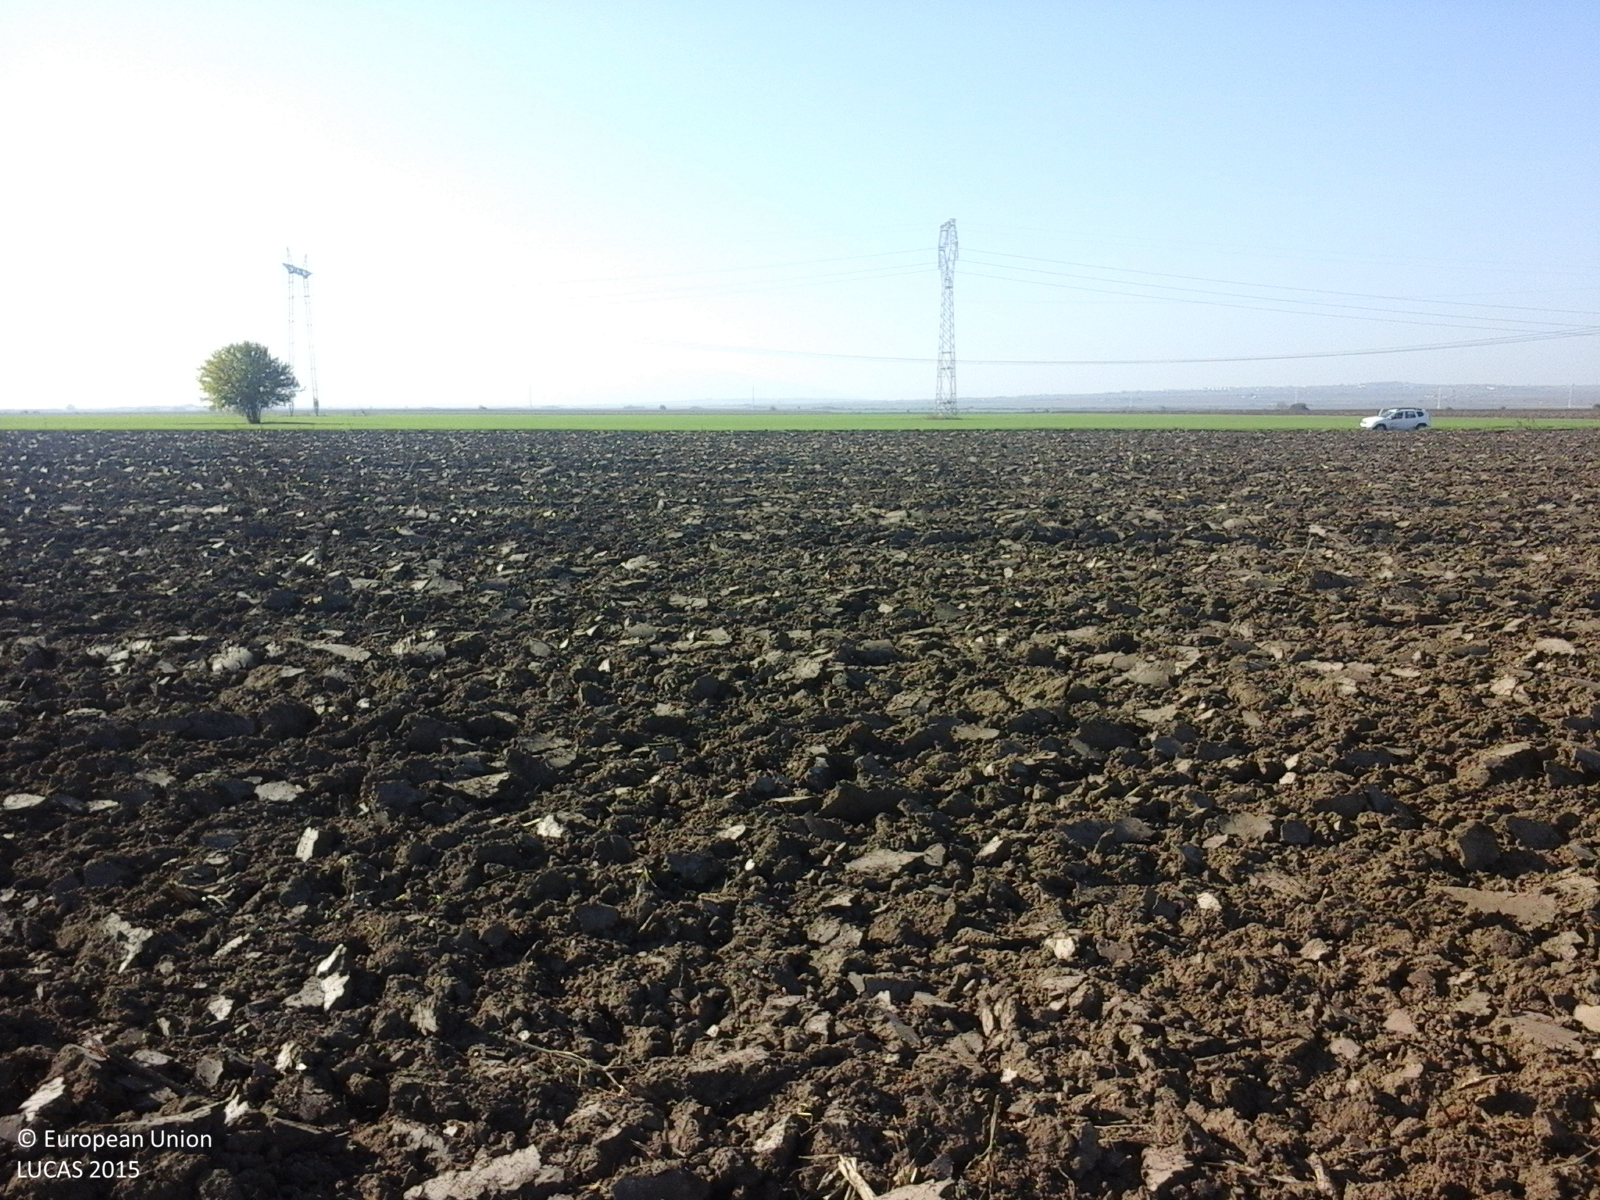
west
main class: Cropland
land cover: Maize
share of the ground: < 10 %
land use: Agriculture (excluding fallow land and kitchen gardens)
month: October
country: RO
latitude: 45.8835
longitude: 27.1957
